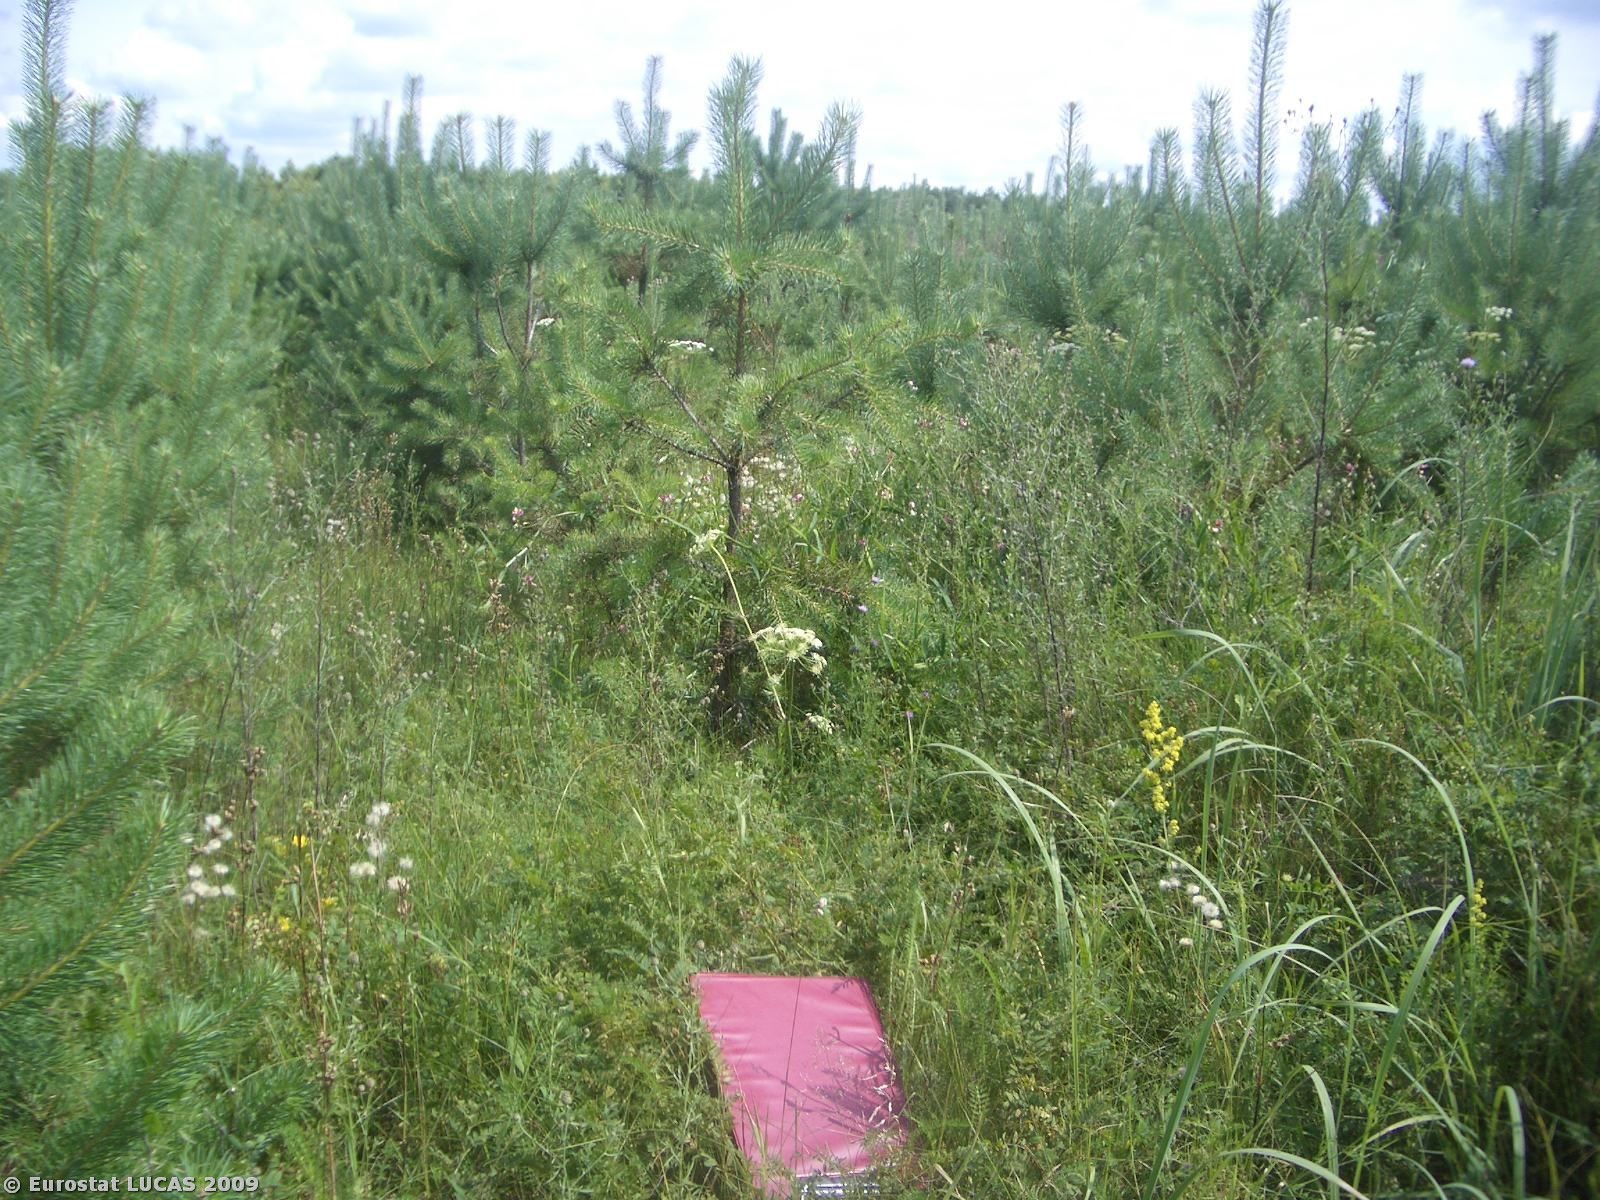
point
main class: Woodland
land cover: Coniferous woodland
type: hemiboreal forest and nemoral coniferous forest and mixed broadleaved-coniferous forest
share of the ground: 50 - 75 %
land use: Forestry
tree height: > 5 m
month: July
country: PL
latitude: 52.3404
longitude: 23.0958
